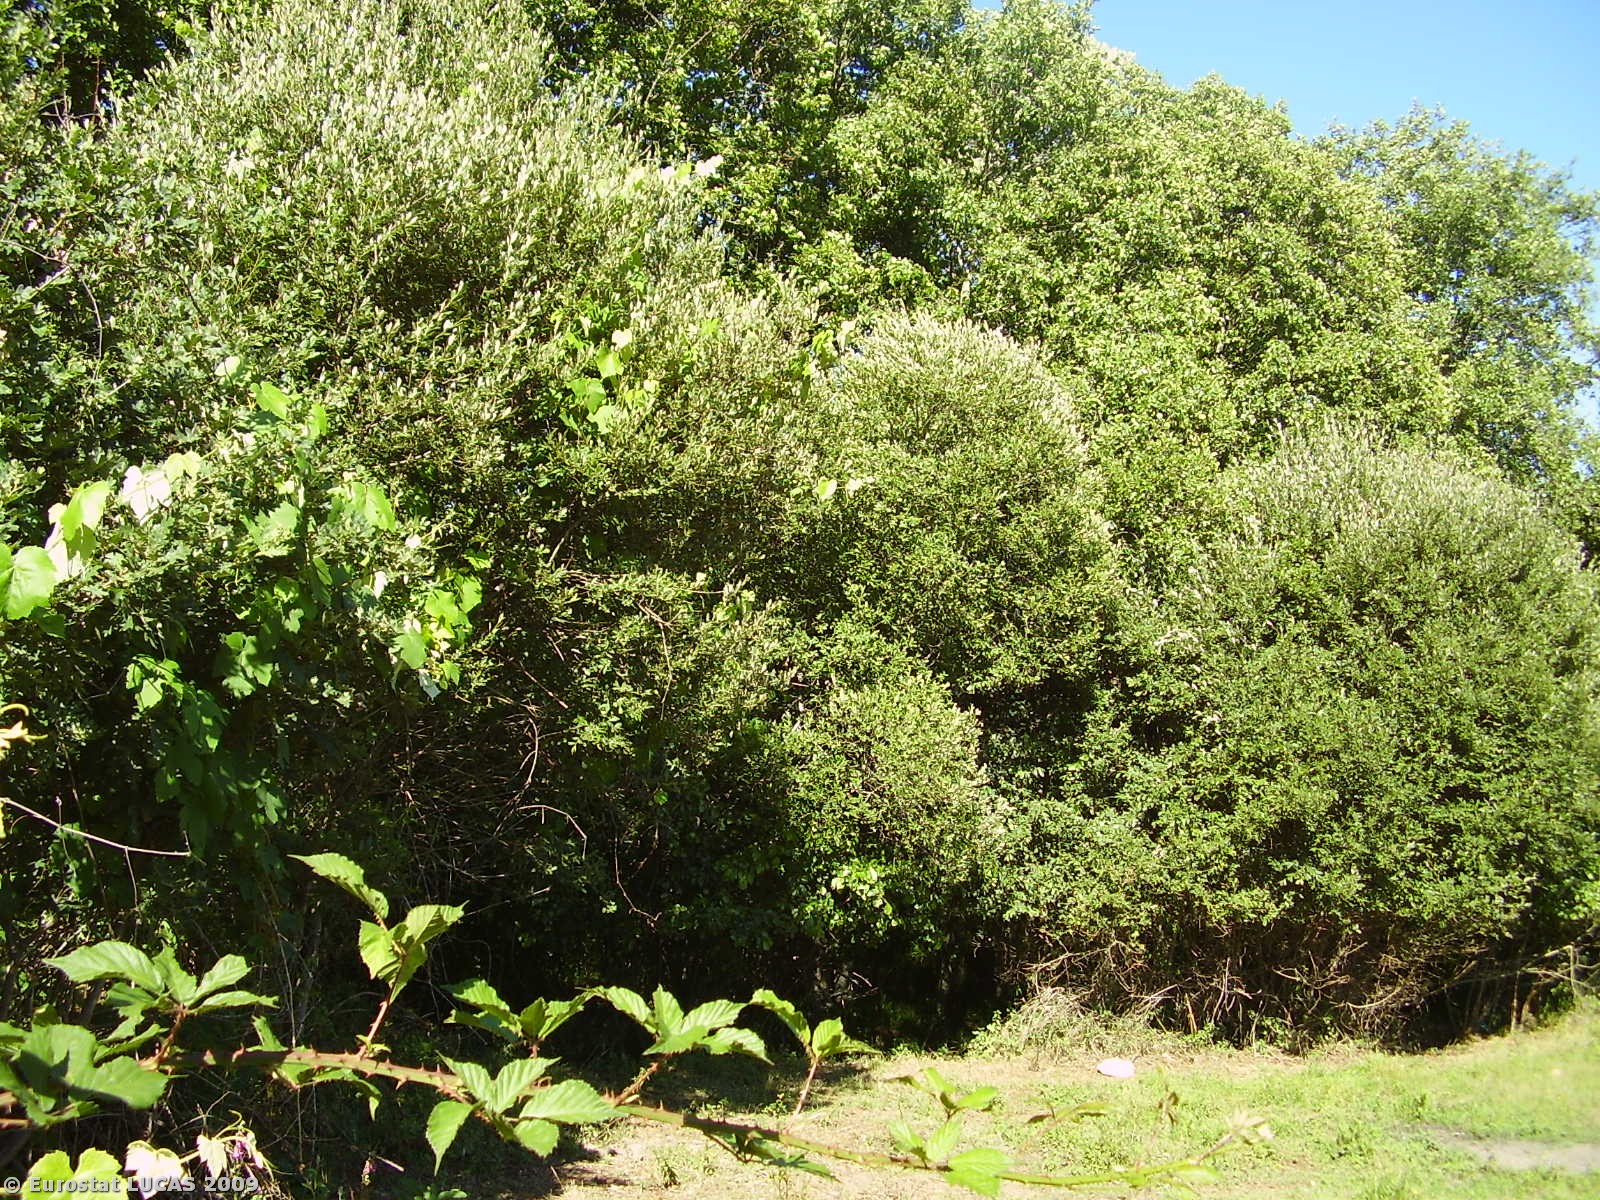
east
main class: Shrubland
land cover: Shrubland with sparse tree cover
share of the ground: > 75 %
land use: Unused
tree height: > 5 m
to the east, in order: Shrubland with sparse tree cover; Abandoned hedges; Rivers and streams; Abandoned hedges; Shrubland with sparse tree cover; Dry stone walls; Abandoned hedges; Shruby margins; Tracks; Shrubland without tree cover; Dry stone walls; Grass margins; Abandoned hedges; Shrubland without tree cover; Dry stone walls; Fences; Grassland with sparse tree/shrub cover; Abandoned hedges; Dry stone walls; Shrubland with sparse tree cover
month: July
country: PT
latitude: 41.4409
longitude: -7.5417
